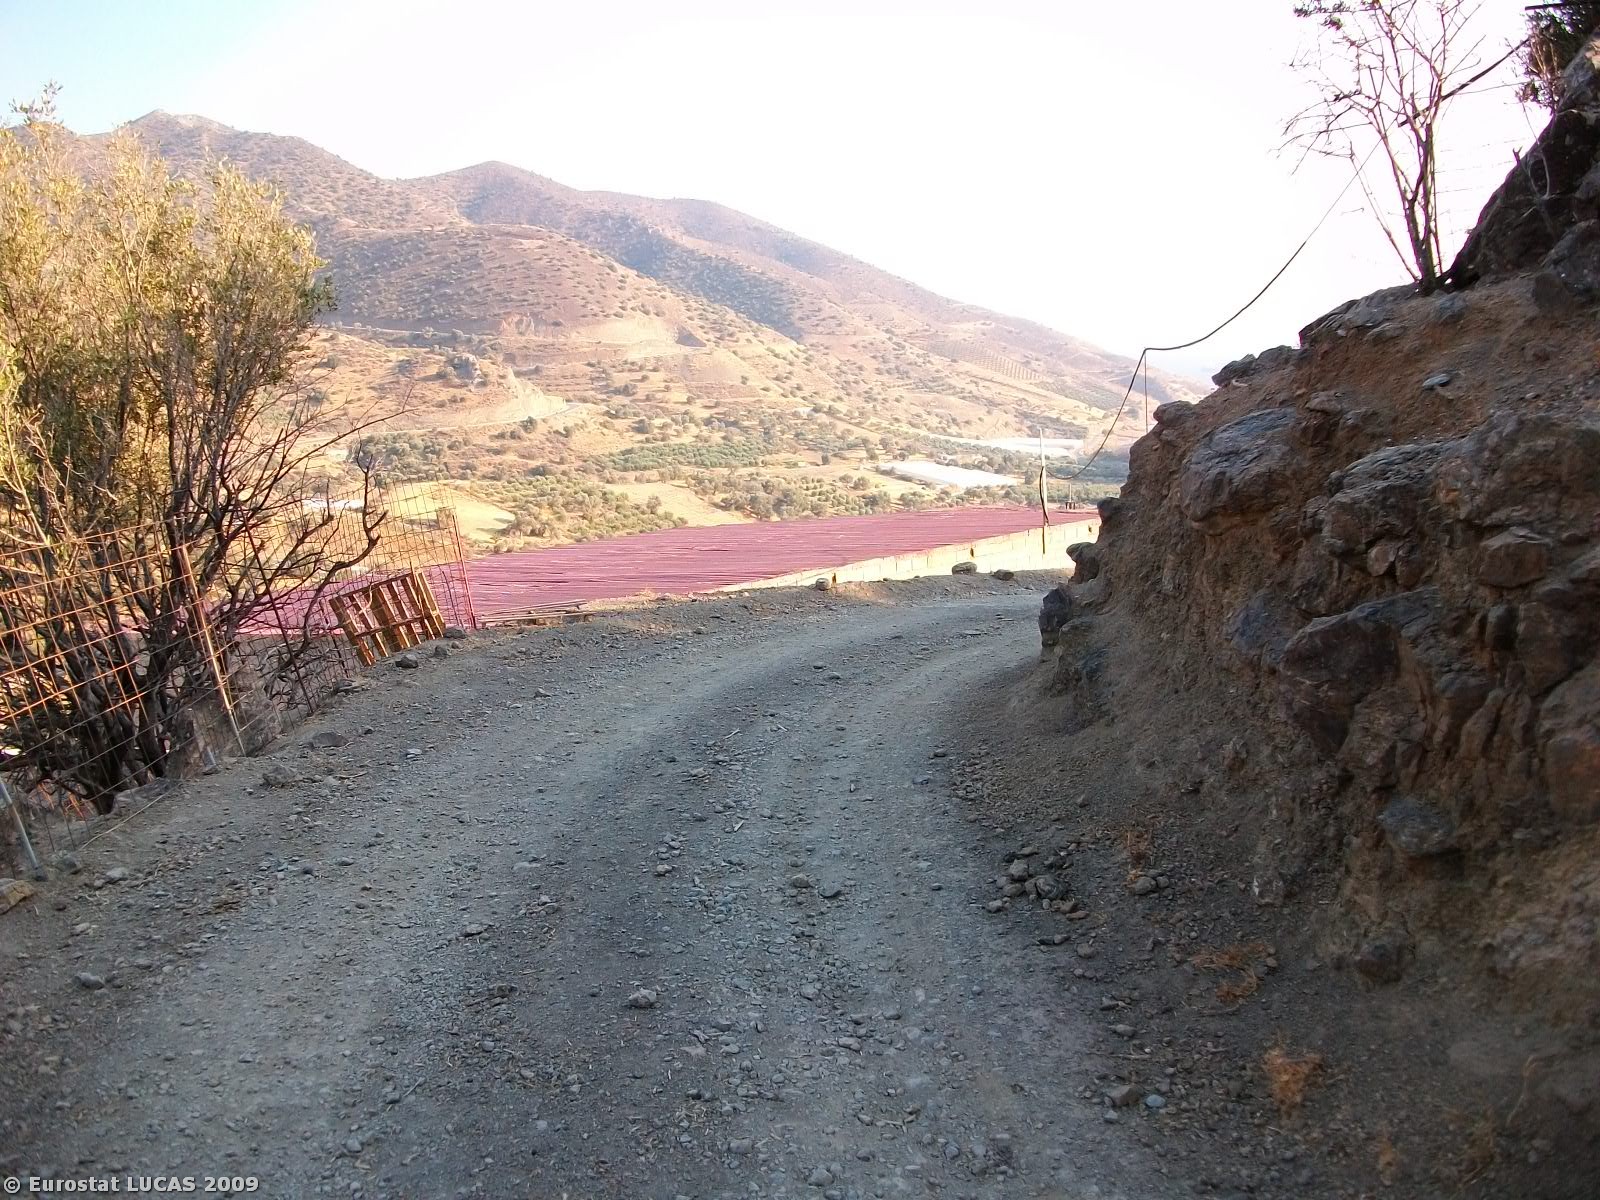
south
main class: Shrubland
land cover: Shrubland with sparse tree cover
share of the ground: 50 - 75 %
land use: Agriculture (excluding fallow land and kitchen gardens)
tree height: < 5 m
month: June
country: GR
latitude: 34.9689
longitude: 24.8676
